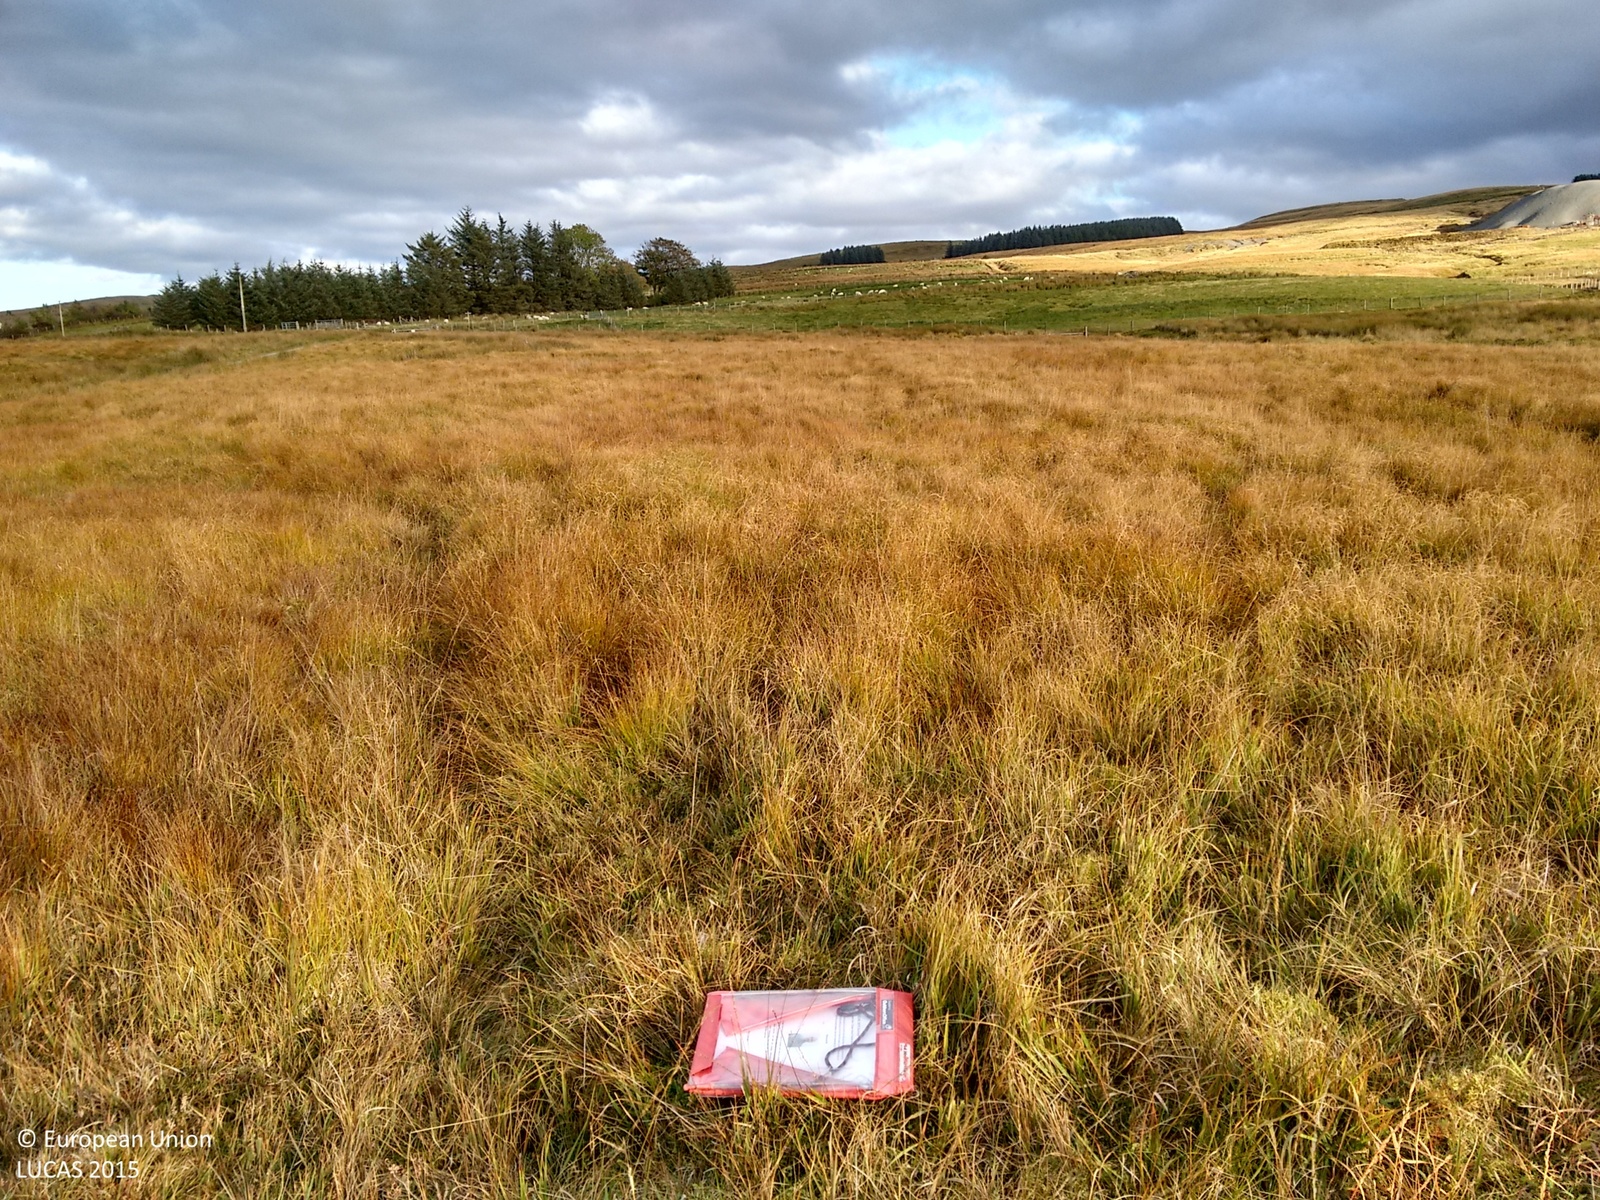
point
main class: Grassland
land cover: Grassland without tree/shrub cover
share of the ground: > 75 %
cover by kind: herbaceous plants 90 %, lichens and mosses 10 %
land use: Agriculture (excluding fallow land and kitchen gardens)
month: October
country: GB
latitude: 52.3105
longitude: -3.8348
